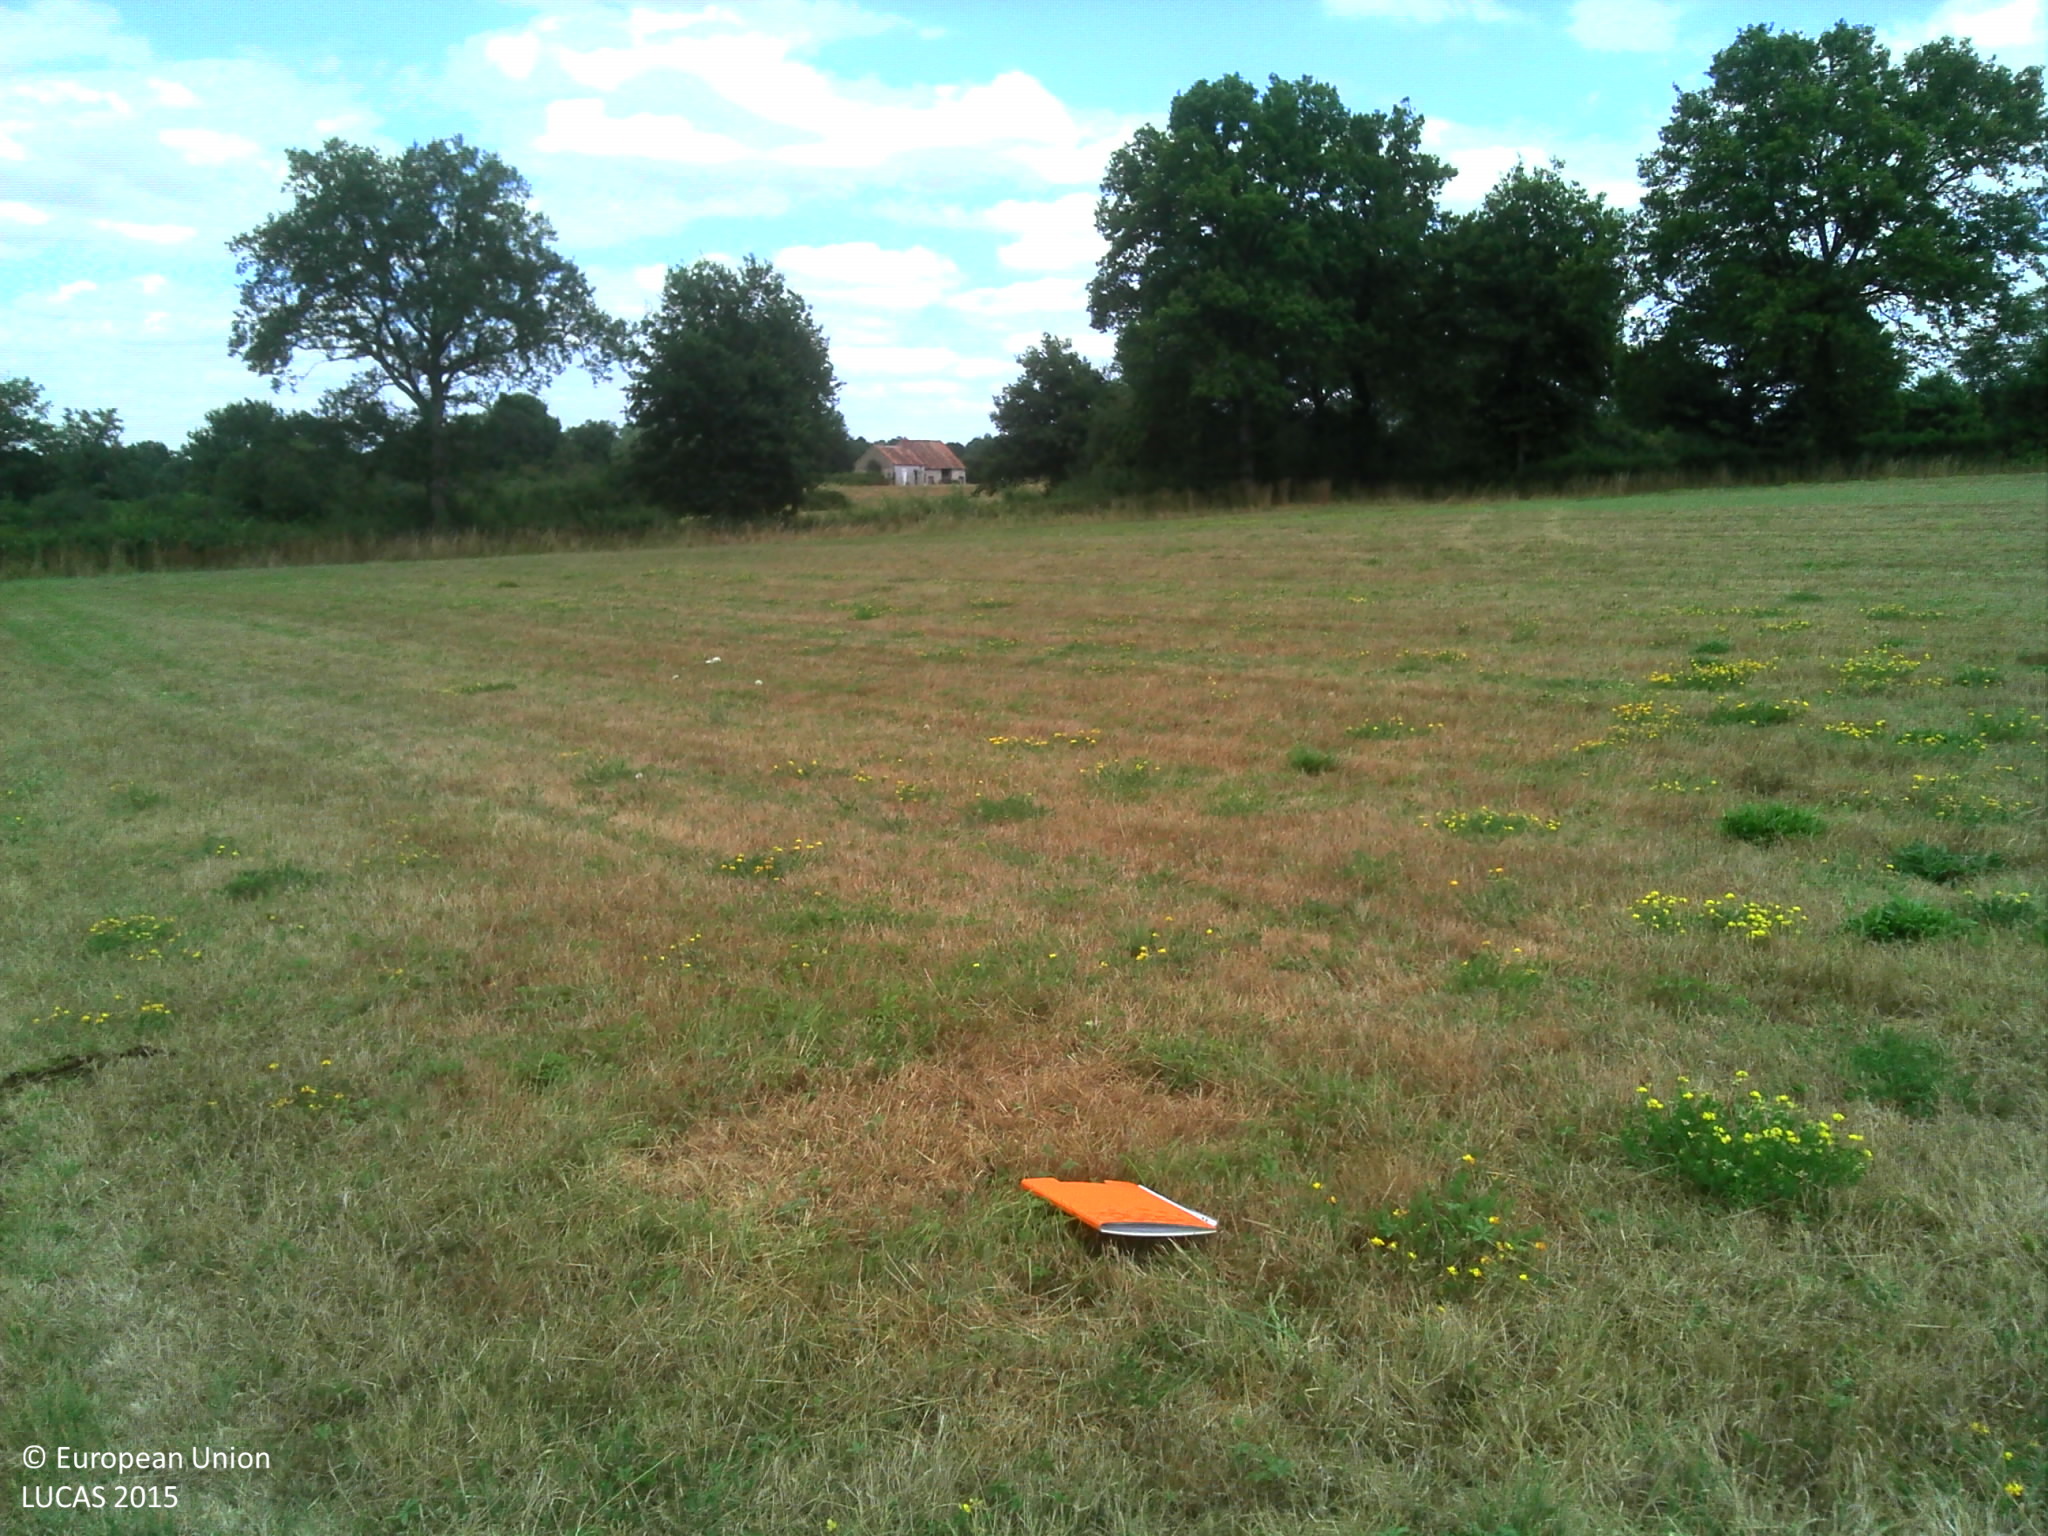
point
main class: Grassland
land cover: Grassland without tree/shrub cover
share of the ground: > 75 %
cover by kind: herbaceous plants 100 %
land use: Agriculture (excluding fallow land and kitchen gardens)
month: July
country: FR
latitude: 46.4910
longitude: 2.8441
